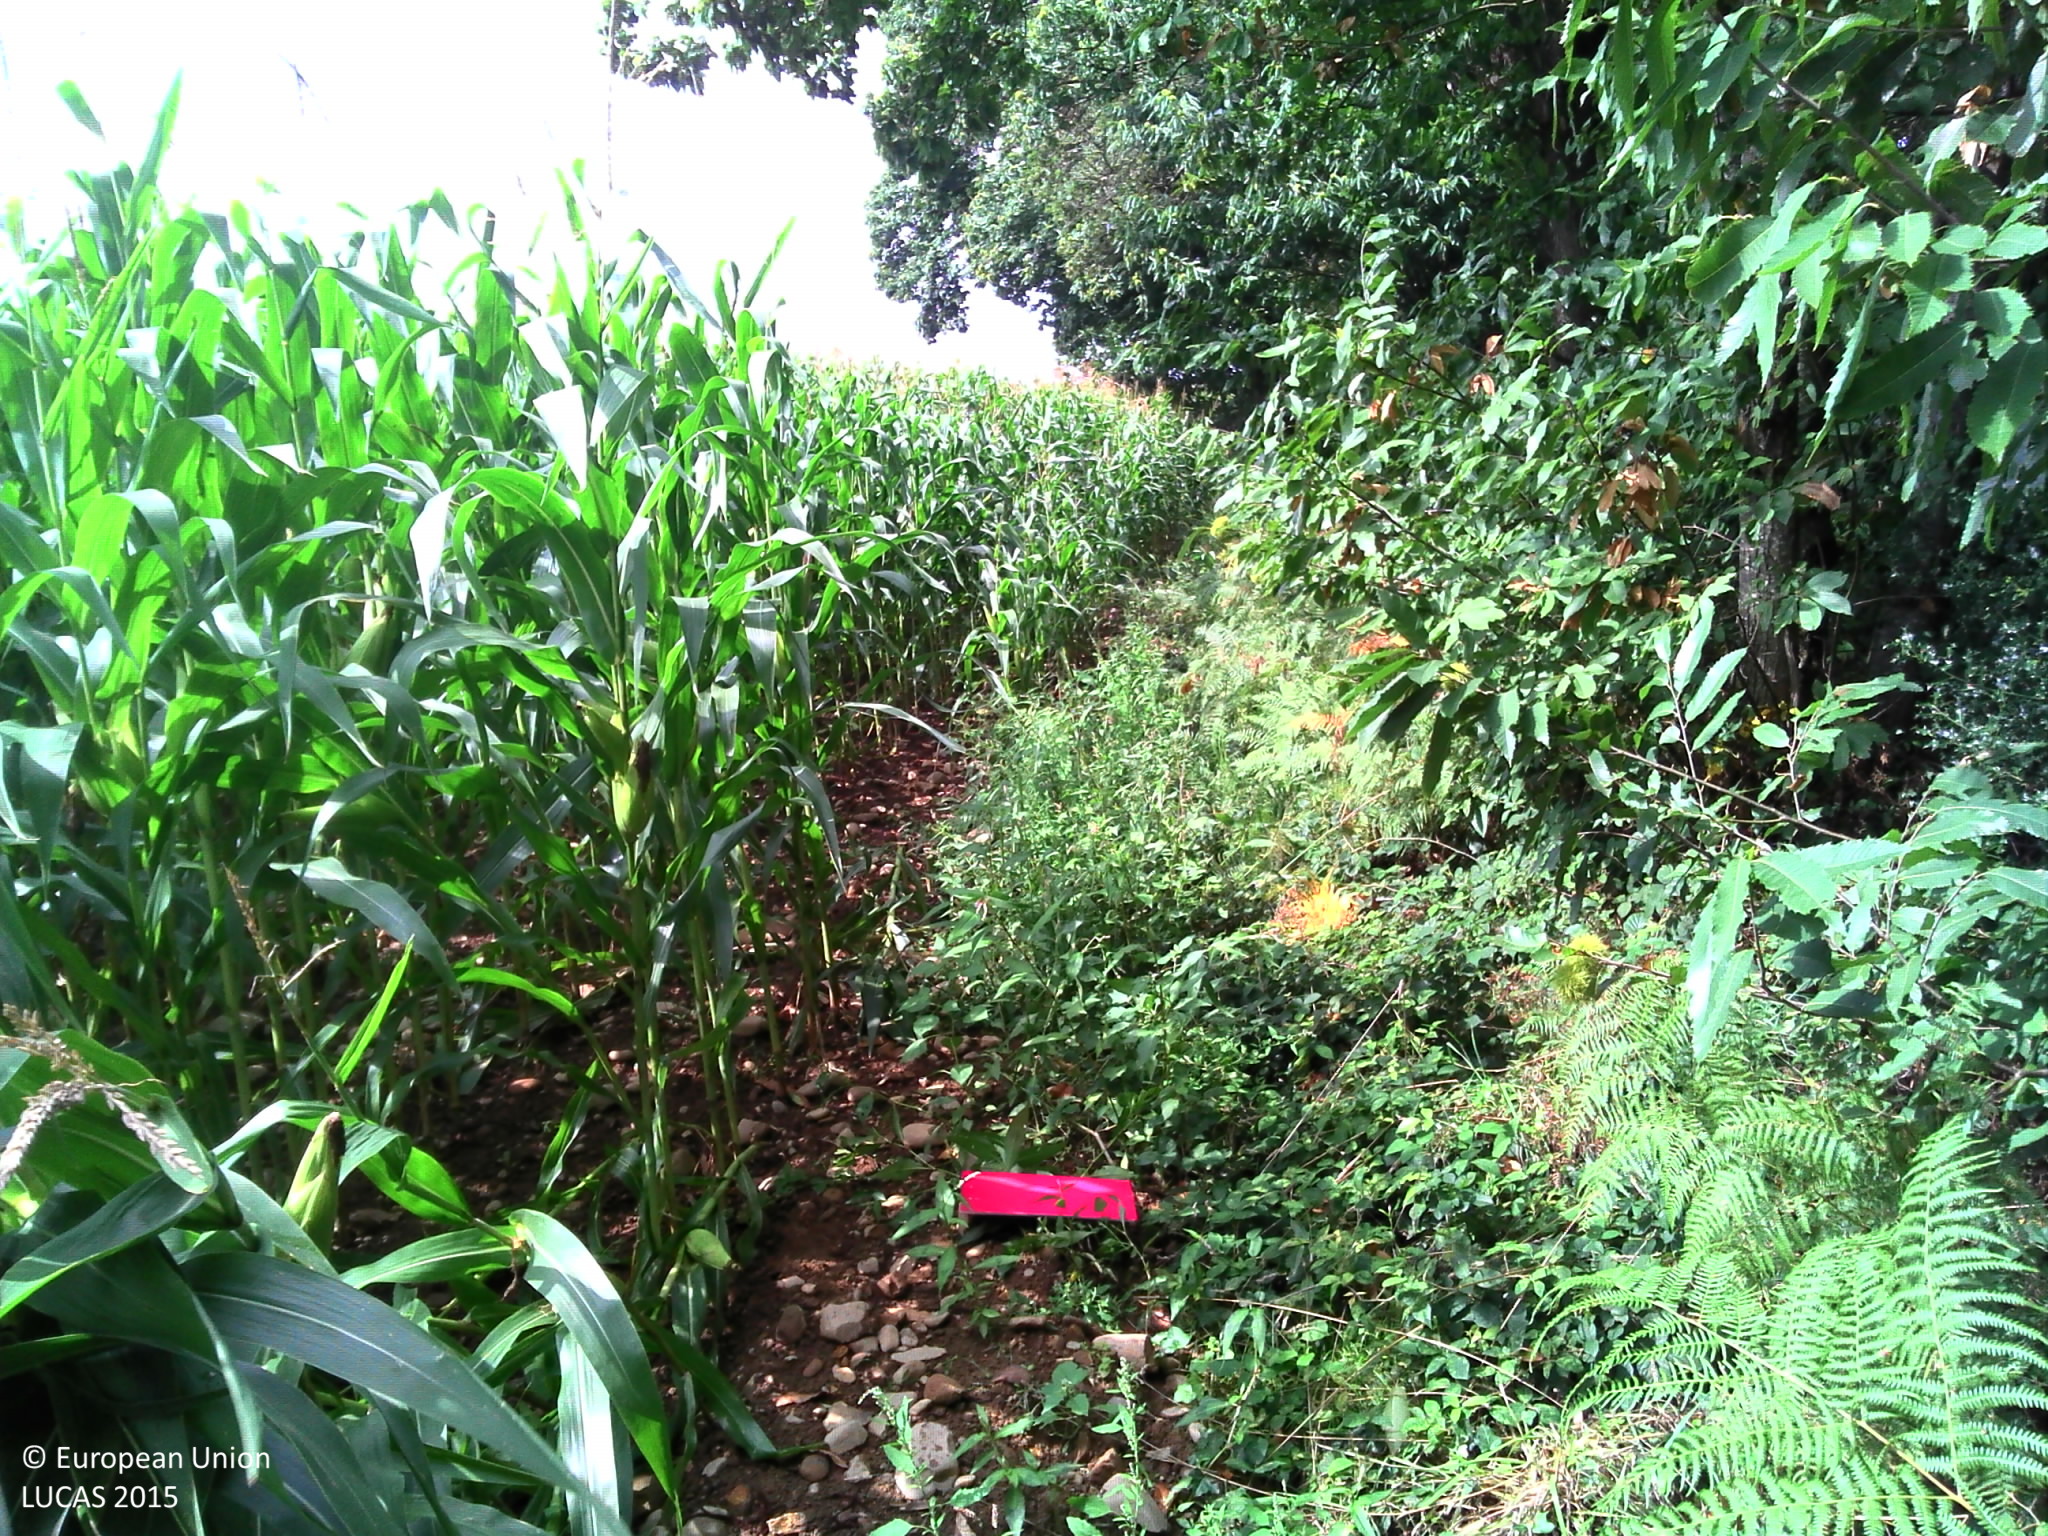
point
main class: Woodland
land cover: Broadleaved woodland
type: mesophytic deciduous forest
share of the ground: > 75 %
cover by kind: broadleaved forest trees 80 %, shrubs 10 %, herbaceous plants 5 %, lichens and mosses 5 %
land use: Forestry
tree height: > 5 m
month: September
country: FR
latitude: 43.4493
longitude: -0.1762
